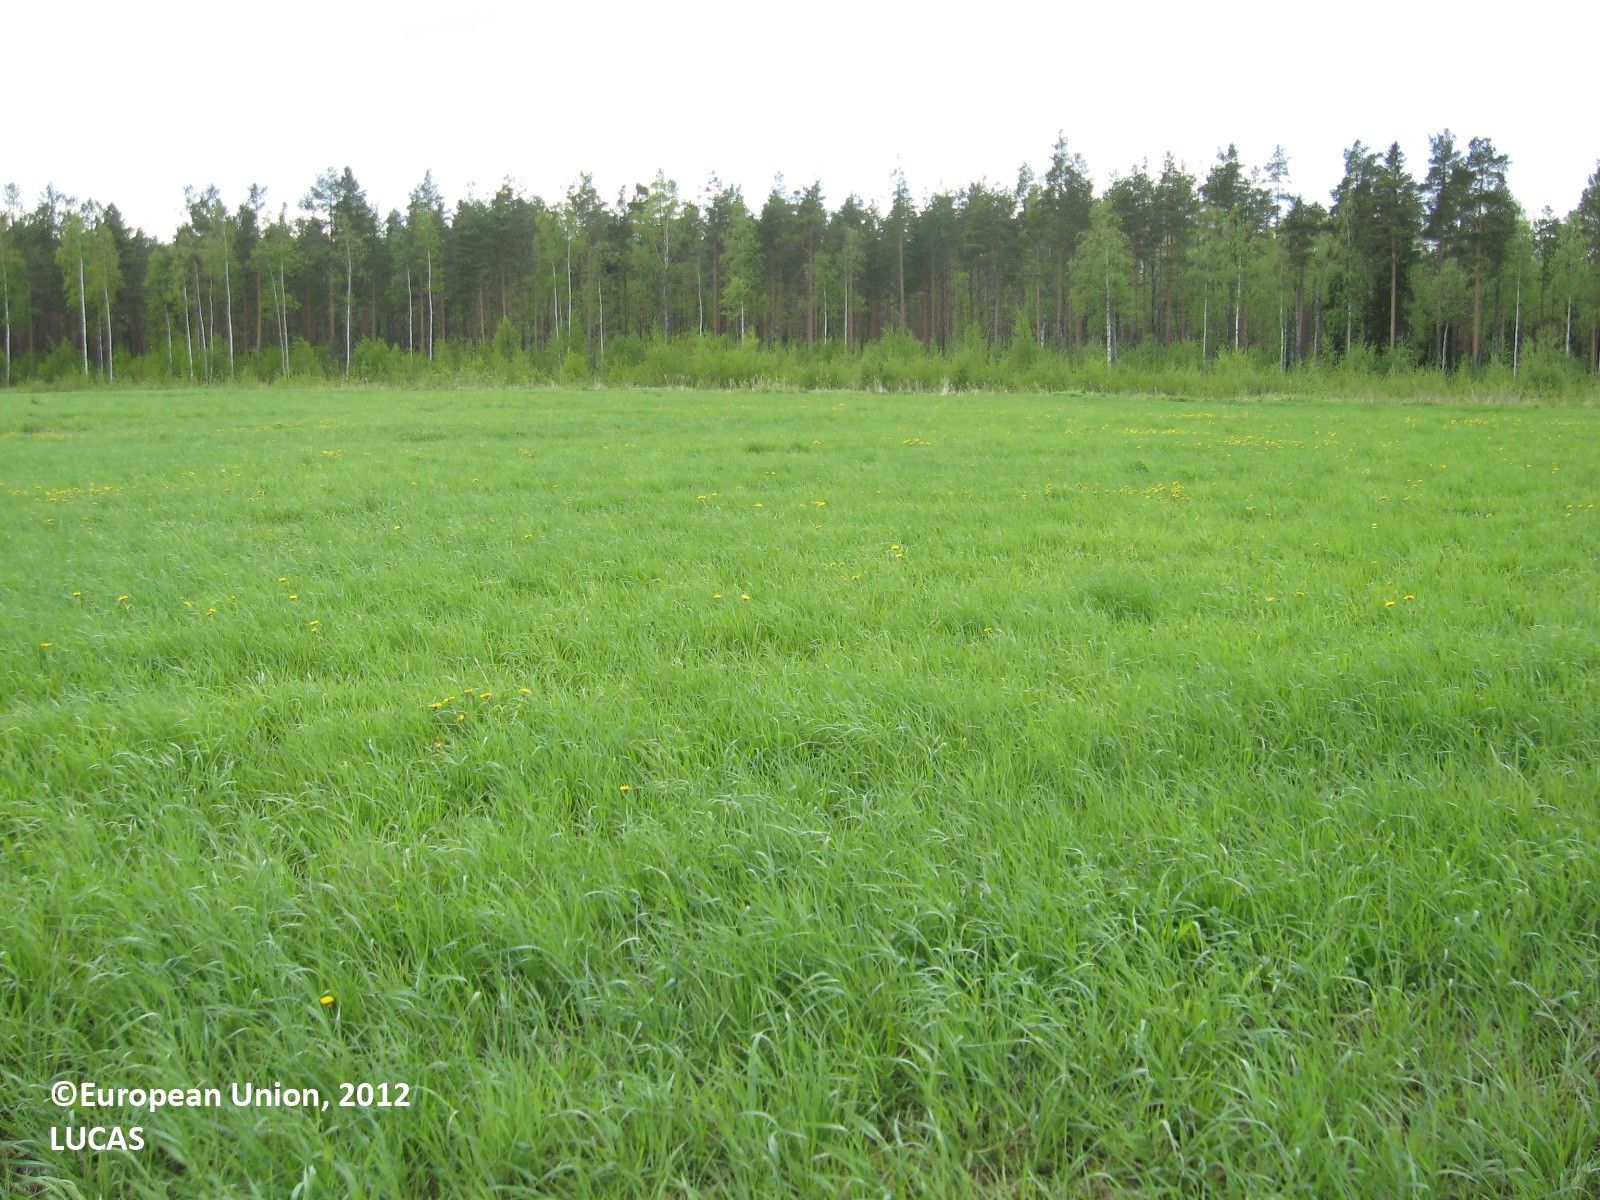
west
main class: Cropland
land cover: Temporary grasslands
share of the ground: > 75 %
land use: Agriculture (excluding fallow land and kitchen gardens)
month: May
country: FI
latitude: 61.8122
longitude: 22.5295
